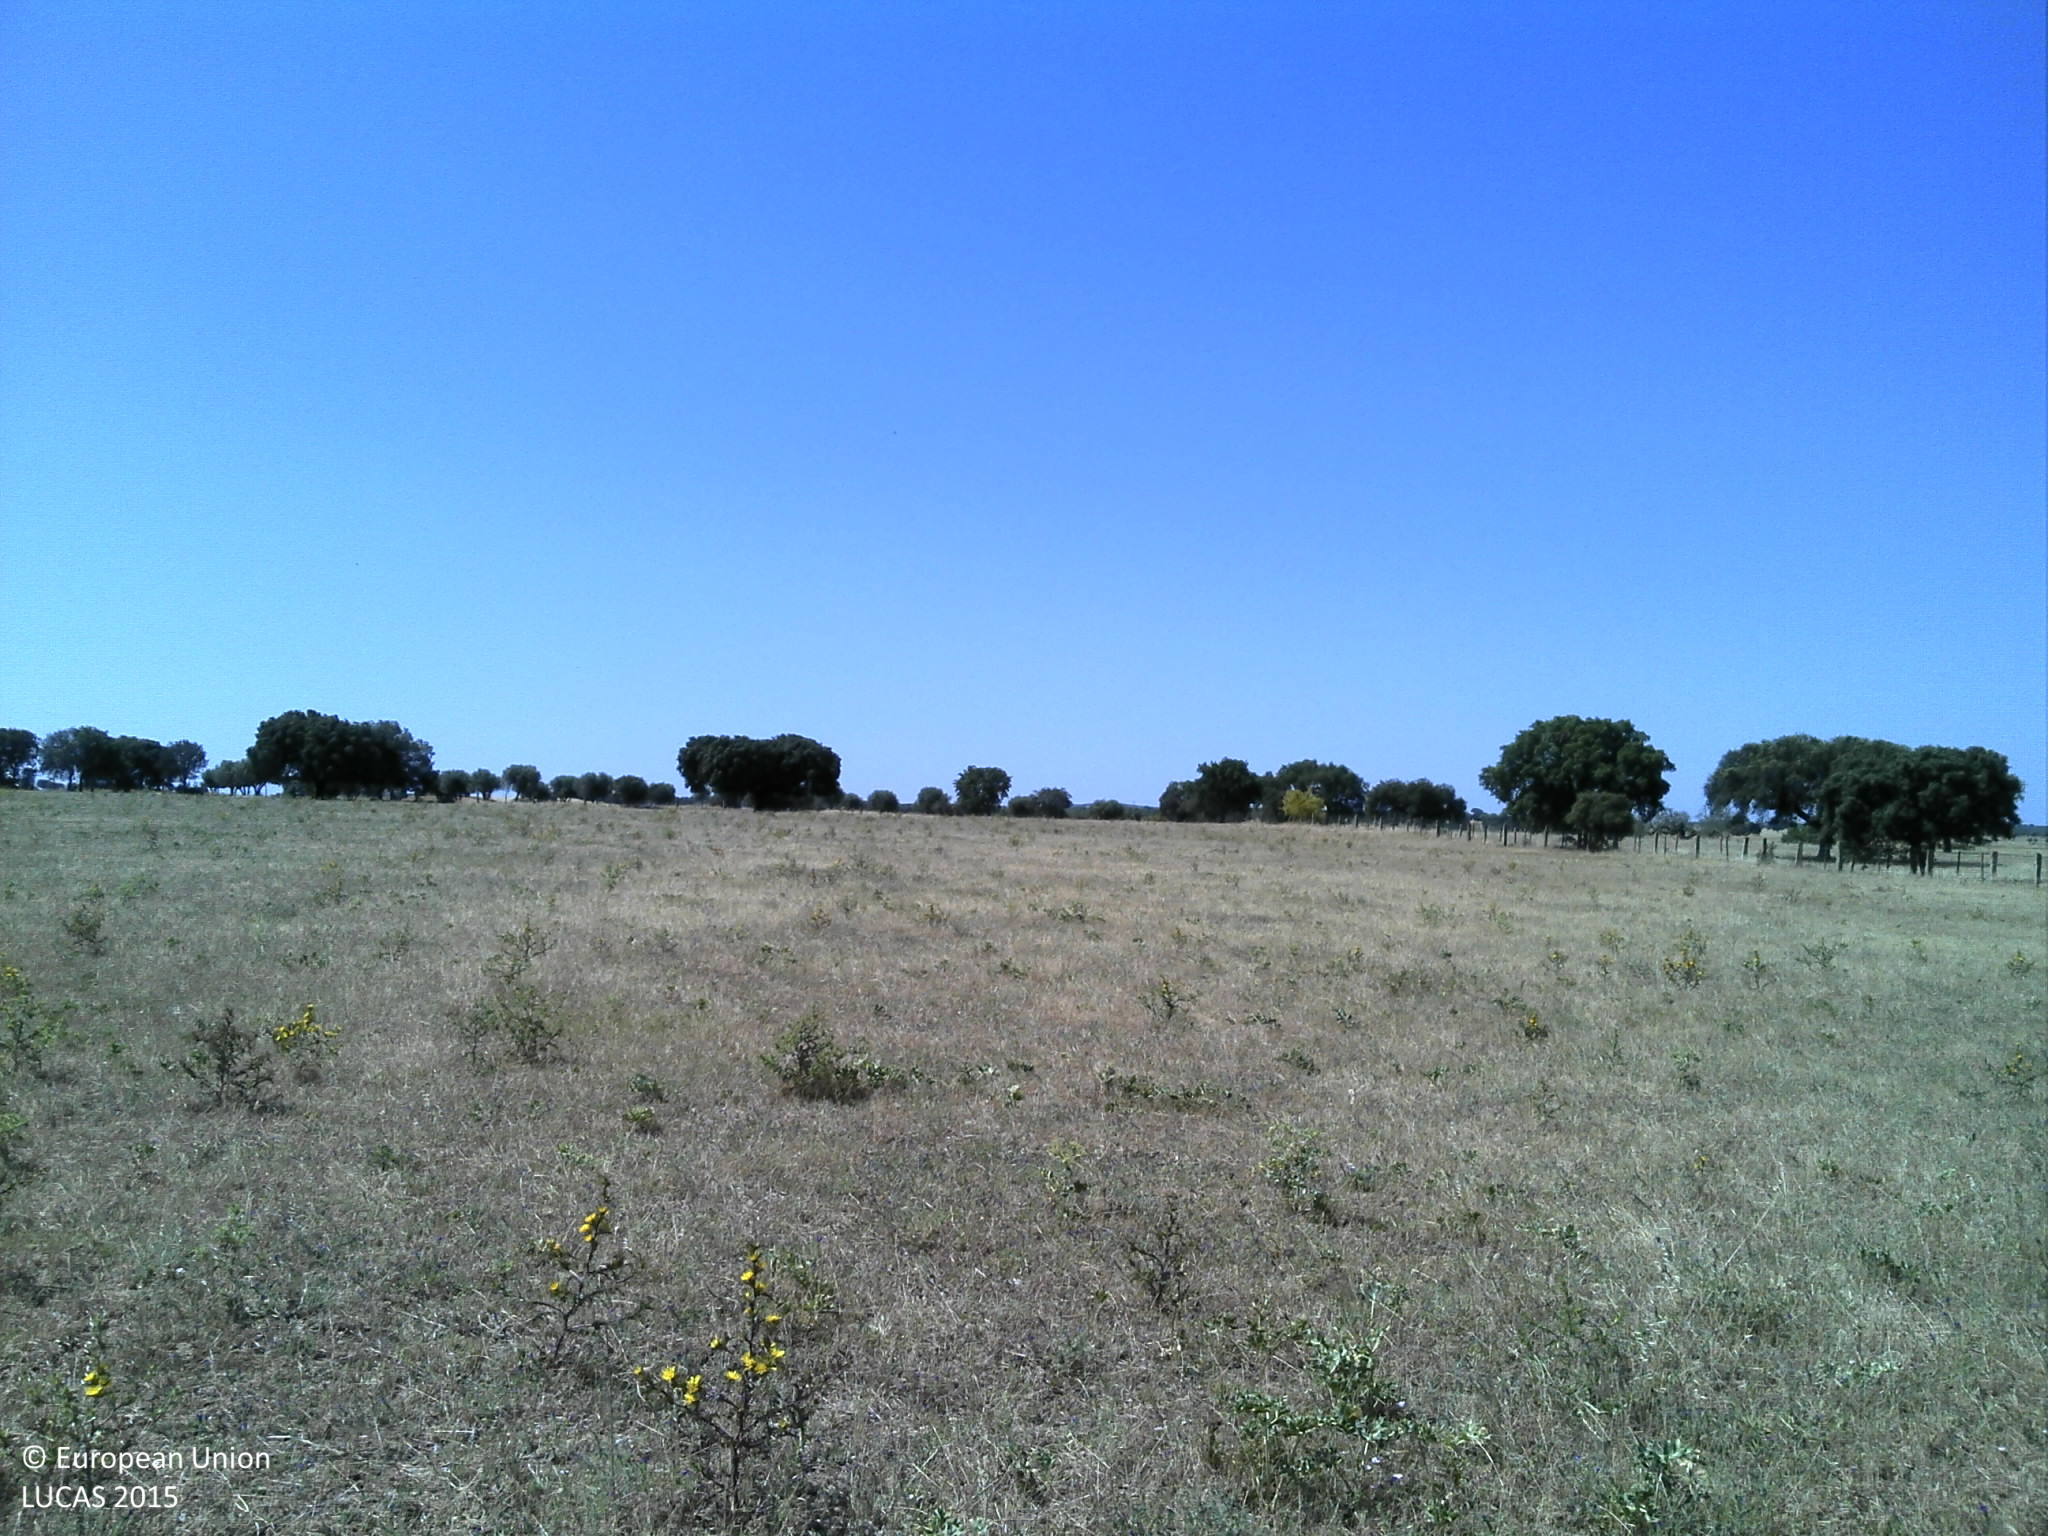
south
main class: Grassland
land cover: Grassland without tree/shrub cover
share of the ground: > 75 %
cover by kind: herbaceous plants 90 %, unconsolidated bare surface 10 %
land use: Agriculture (excluding fallow land and kitchen gardens)
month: June
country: PT
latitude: 38.8034
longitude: -7.8326
